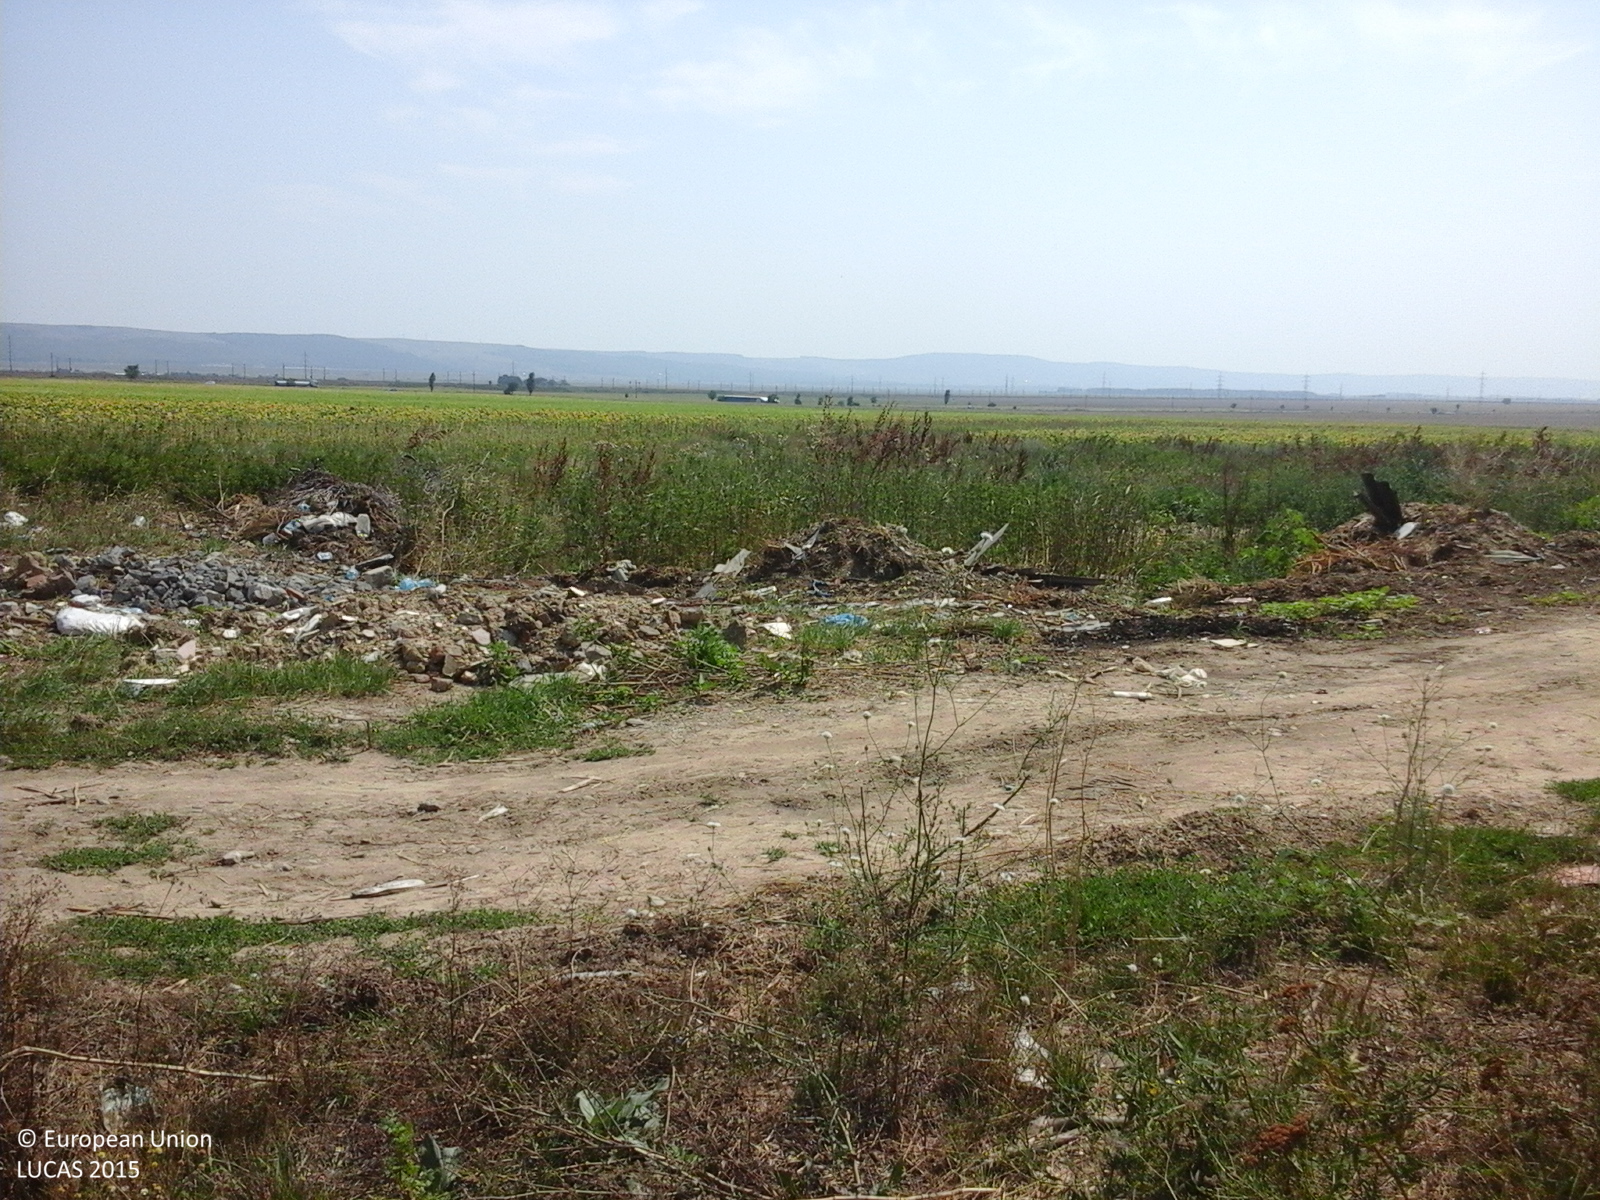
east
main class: Cropland
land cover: Maize
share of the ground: > 75 %
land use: Agriculture (excluding fallow land and kitchen gardens)
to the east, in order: Maize; Common wheat; Grass margins; Fences; Spontaneously vegetated surfaces; Tracks; Spontaneously vegetated surfaces; Sunflower
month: August
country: RO
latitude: 46.1919
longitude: 27.1096
